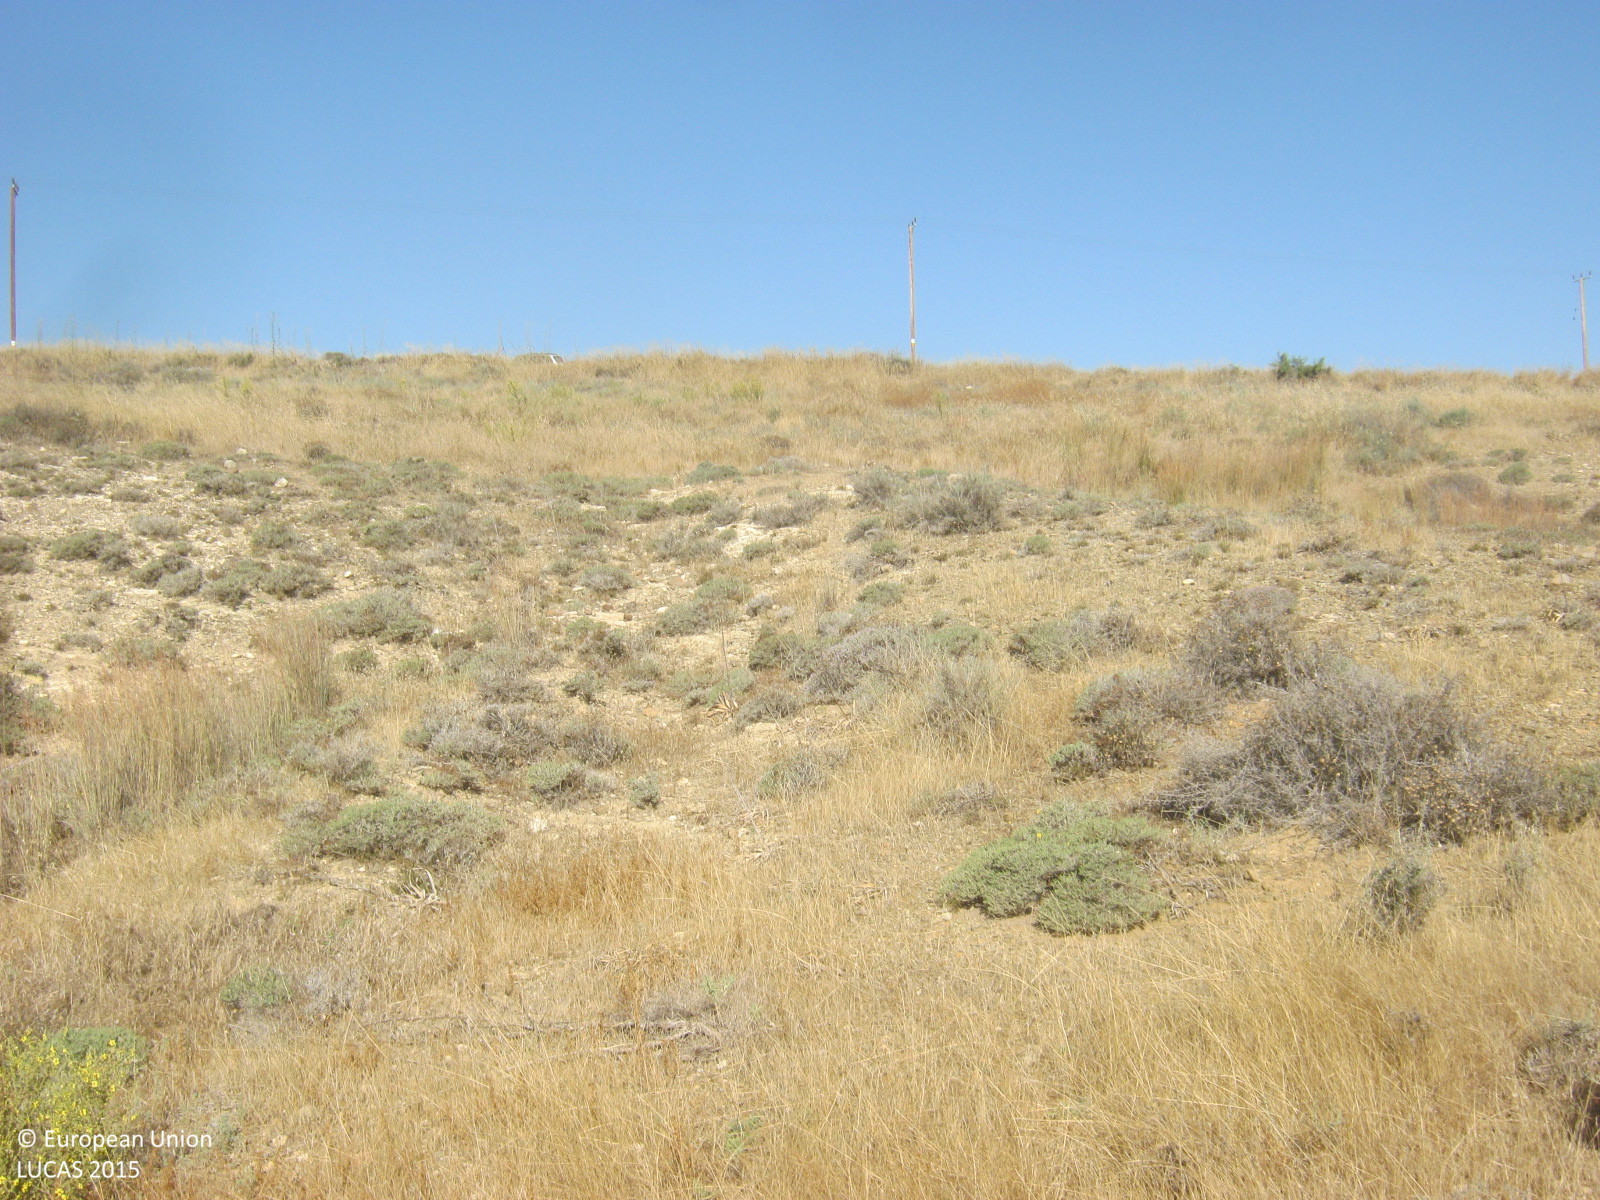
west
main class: Shrubland
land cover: Shrubland without tree cover
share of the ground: 10 - 25 %
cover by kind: herbaceous plants 70 %, shrubs 15 %, unconsolidated bare surface 15 %
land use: Semi-natural and natural areas not in use
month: June
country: CY
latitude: 35.1071
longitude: 33.1685
